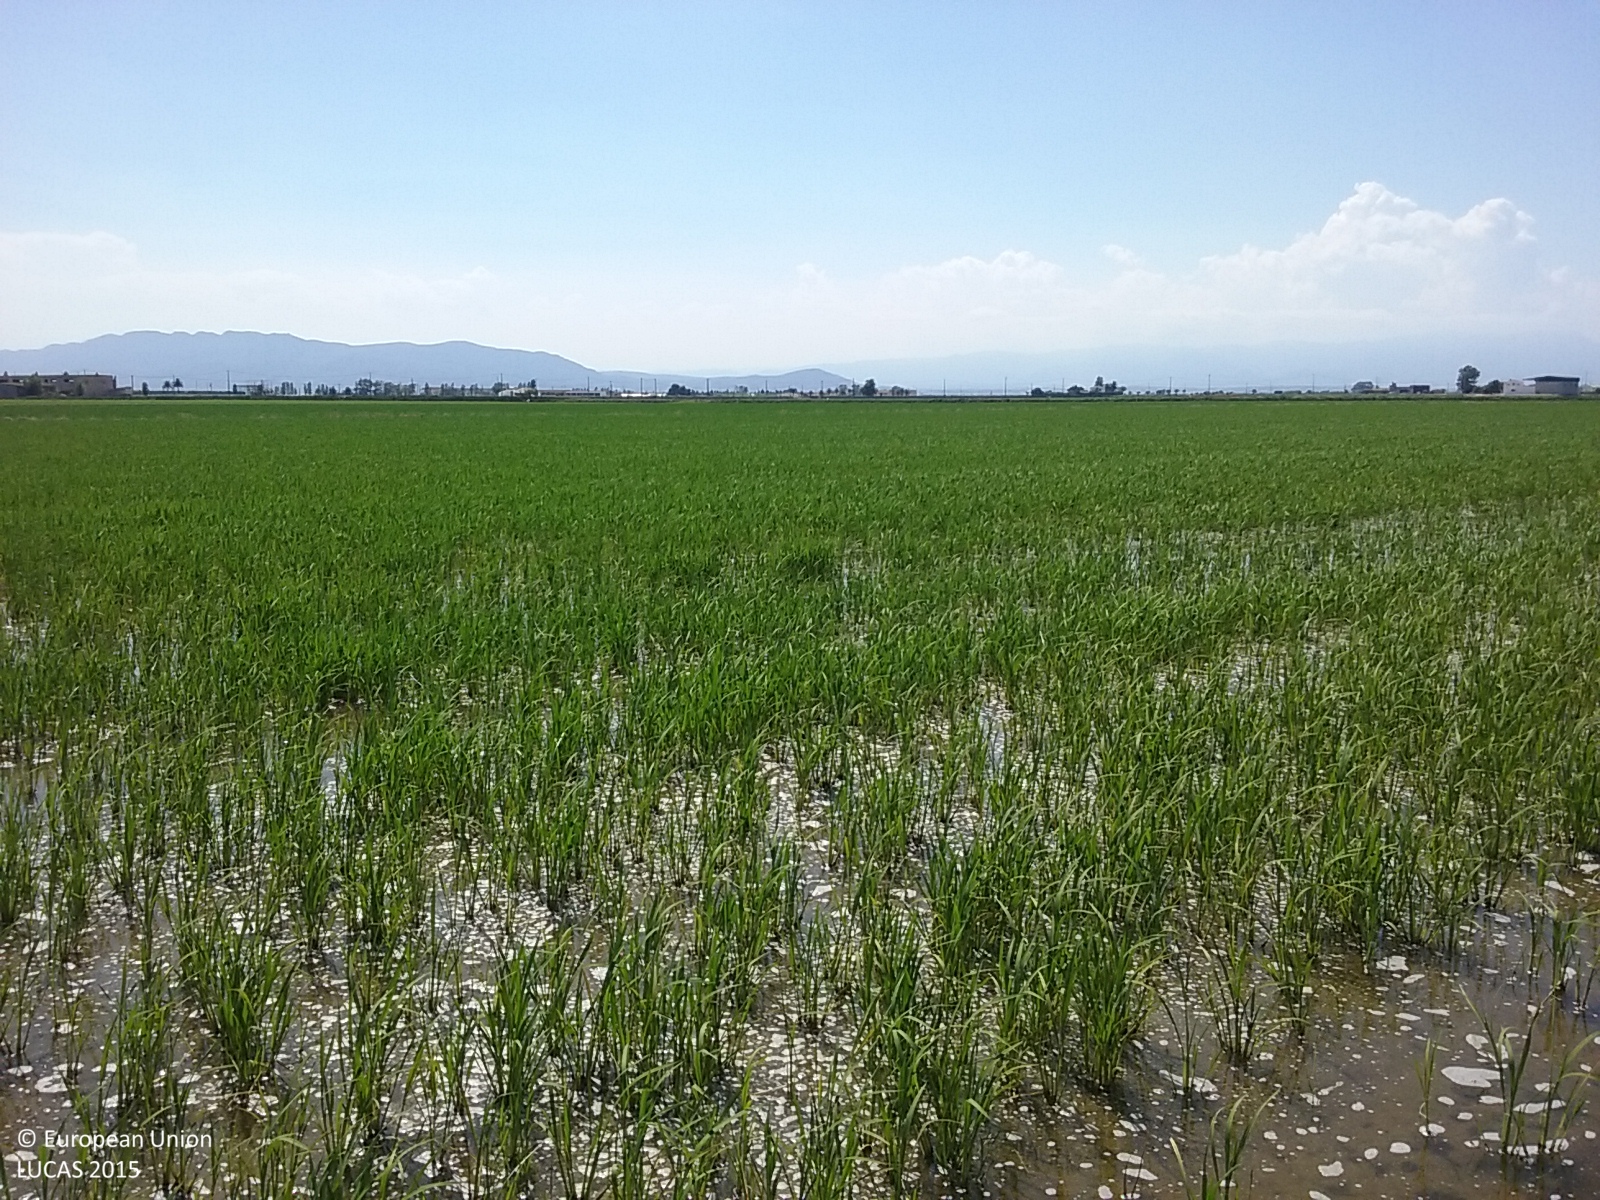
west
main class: Cropland
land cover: Rice
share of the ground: > 75 %
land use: Agriculture (excluding fallow land and kitchen gardens)
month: June
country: ES
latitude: 40.6830
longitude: 0.7313
